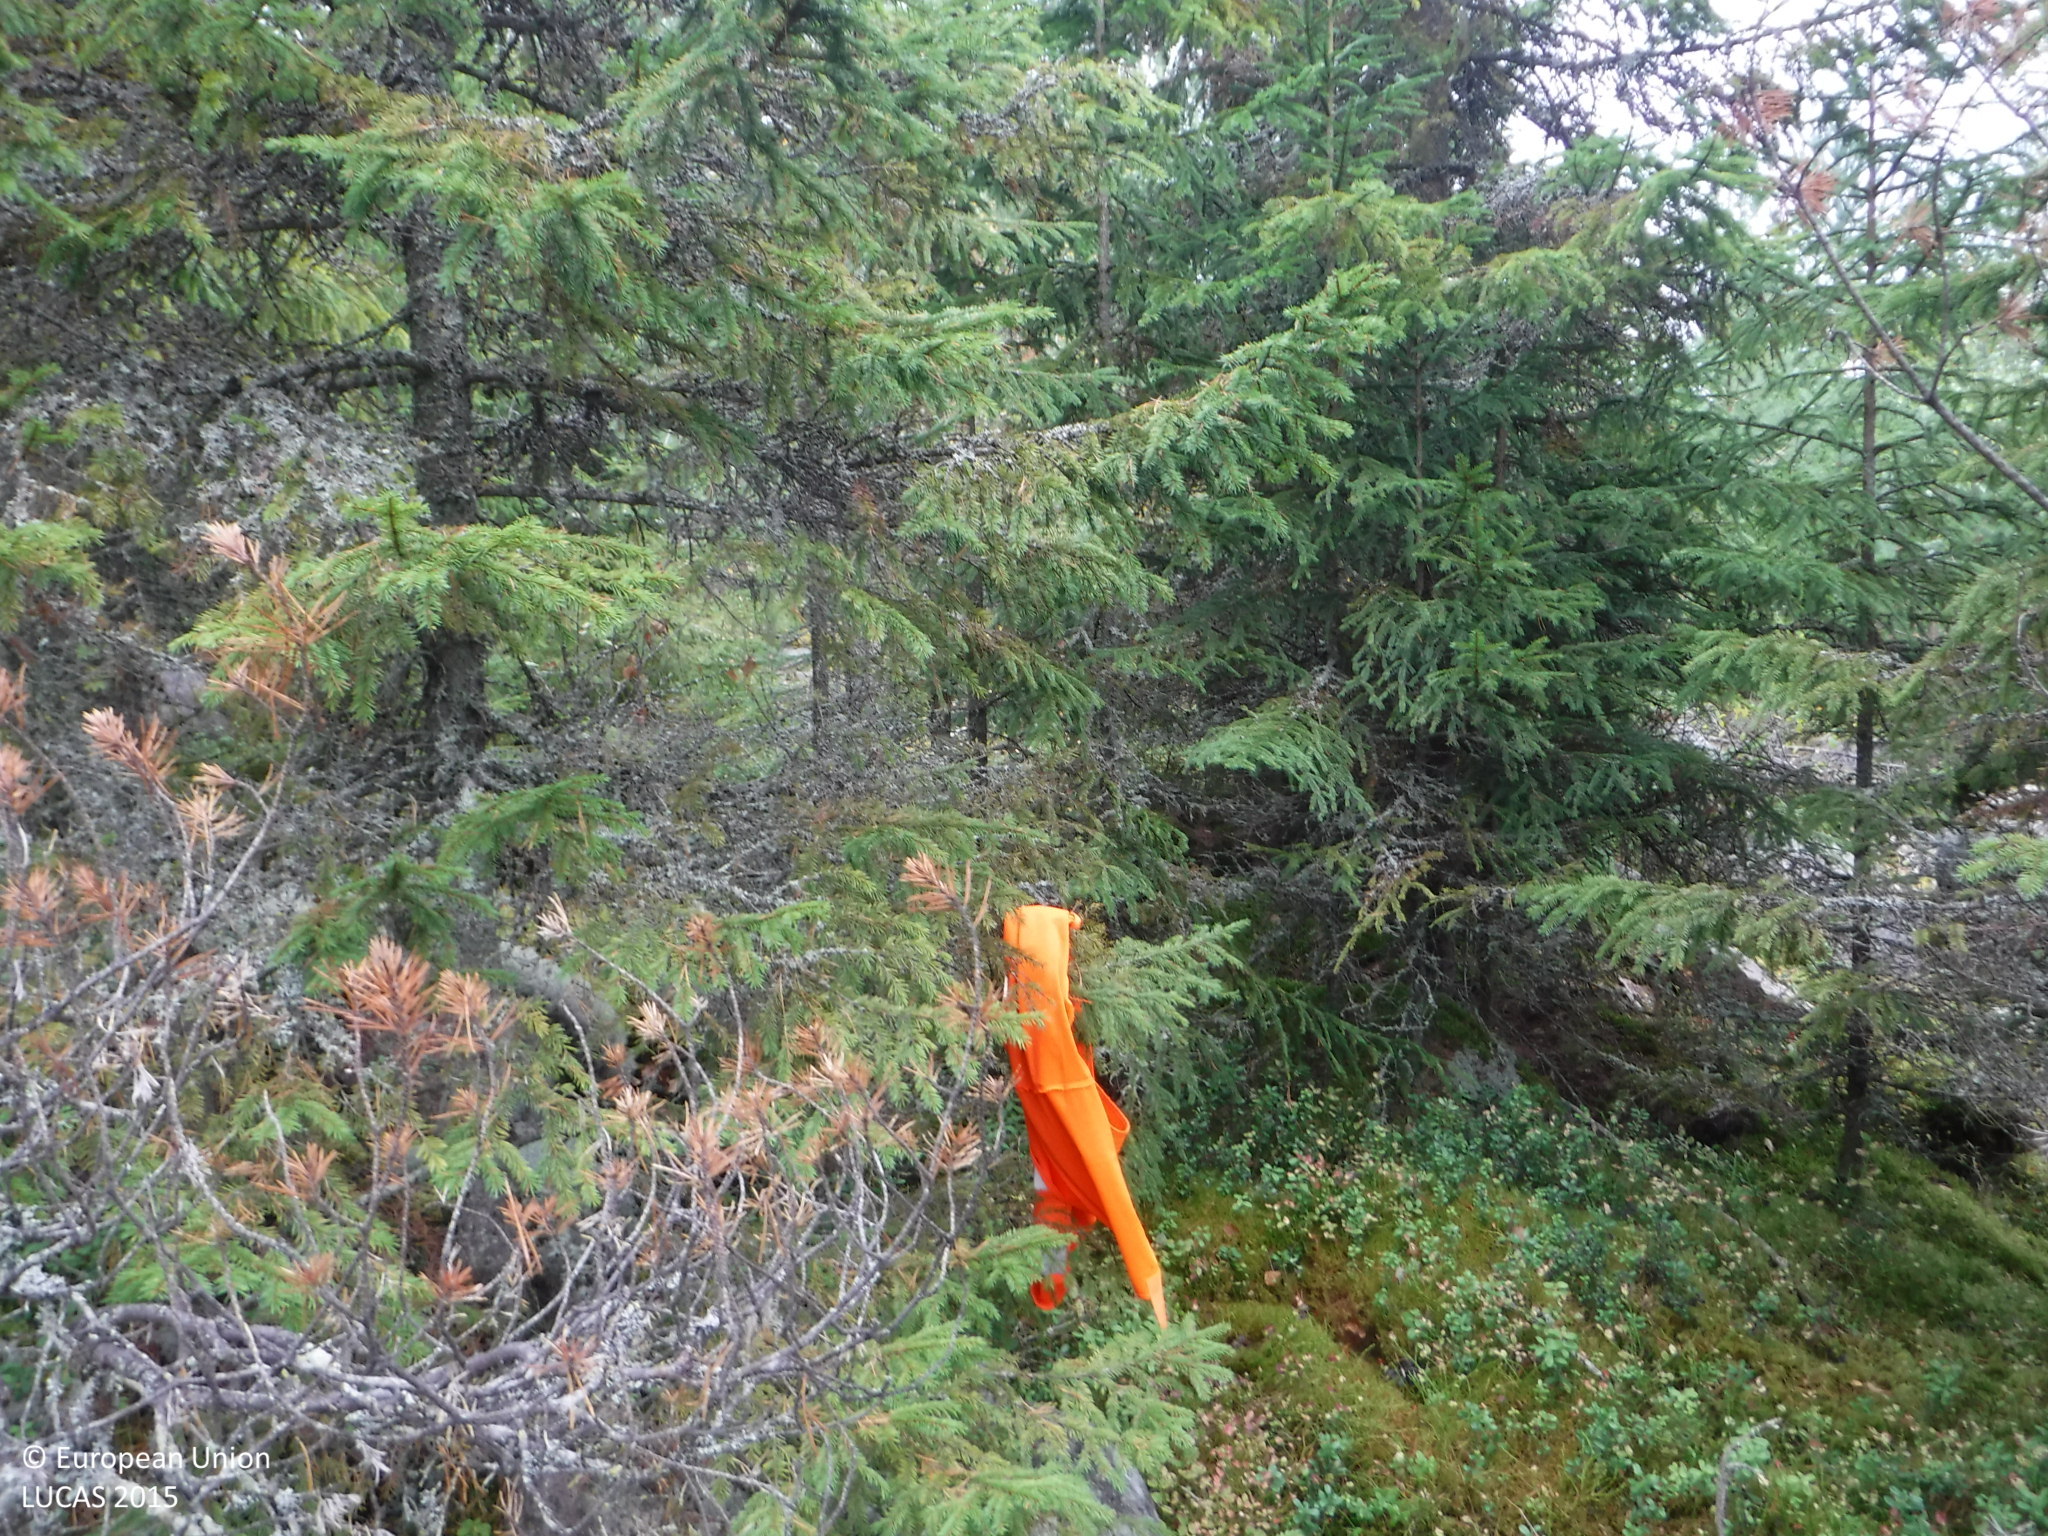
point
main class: Woodland
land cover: Other coniferous woodland
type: boreal forest
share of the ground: 50 - 75 %
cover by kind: coniferous forest trees 55 %, lichens and mosses 25 %, shrubs 20 %
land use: Forestry
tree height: > 5 m
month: September
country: FI
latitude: 61.5752
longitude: 23.9282
